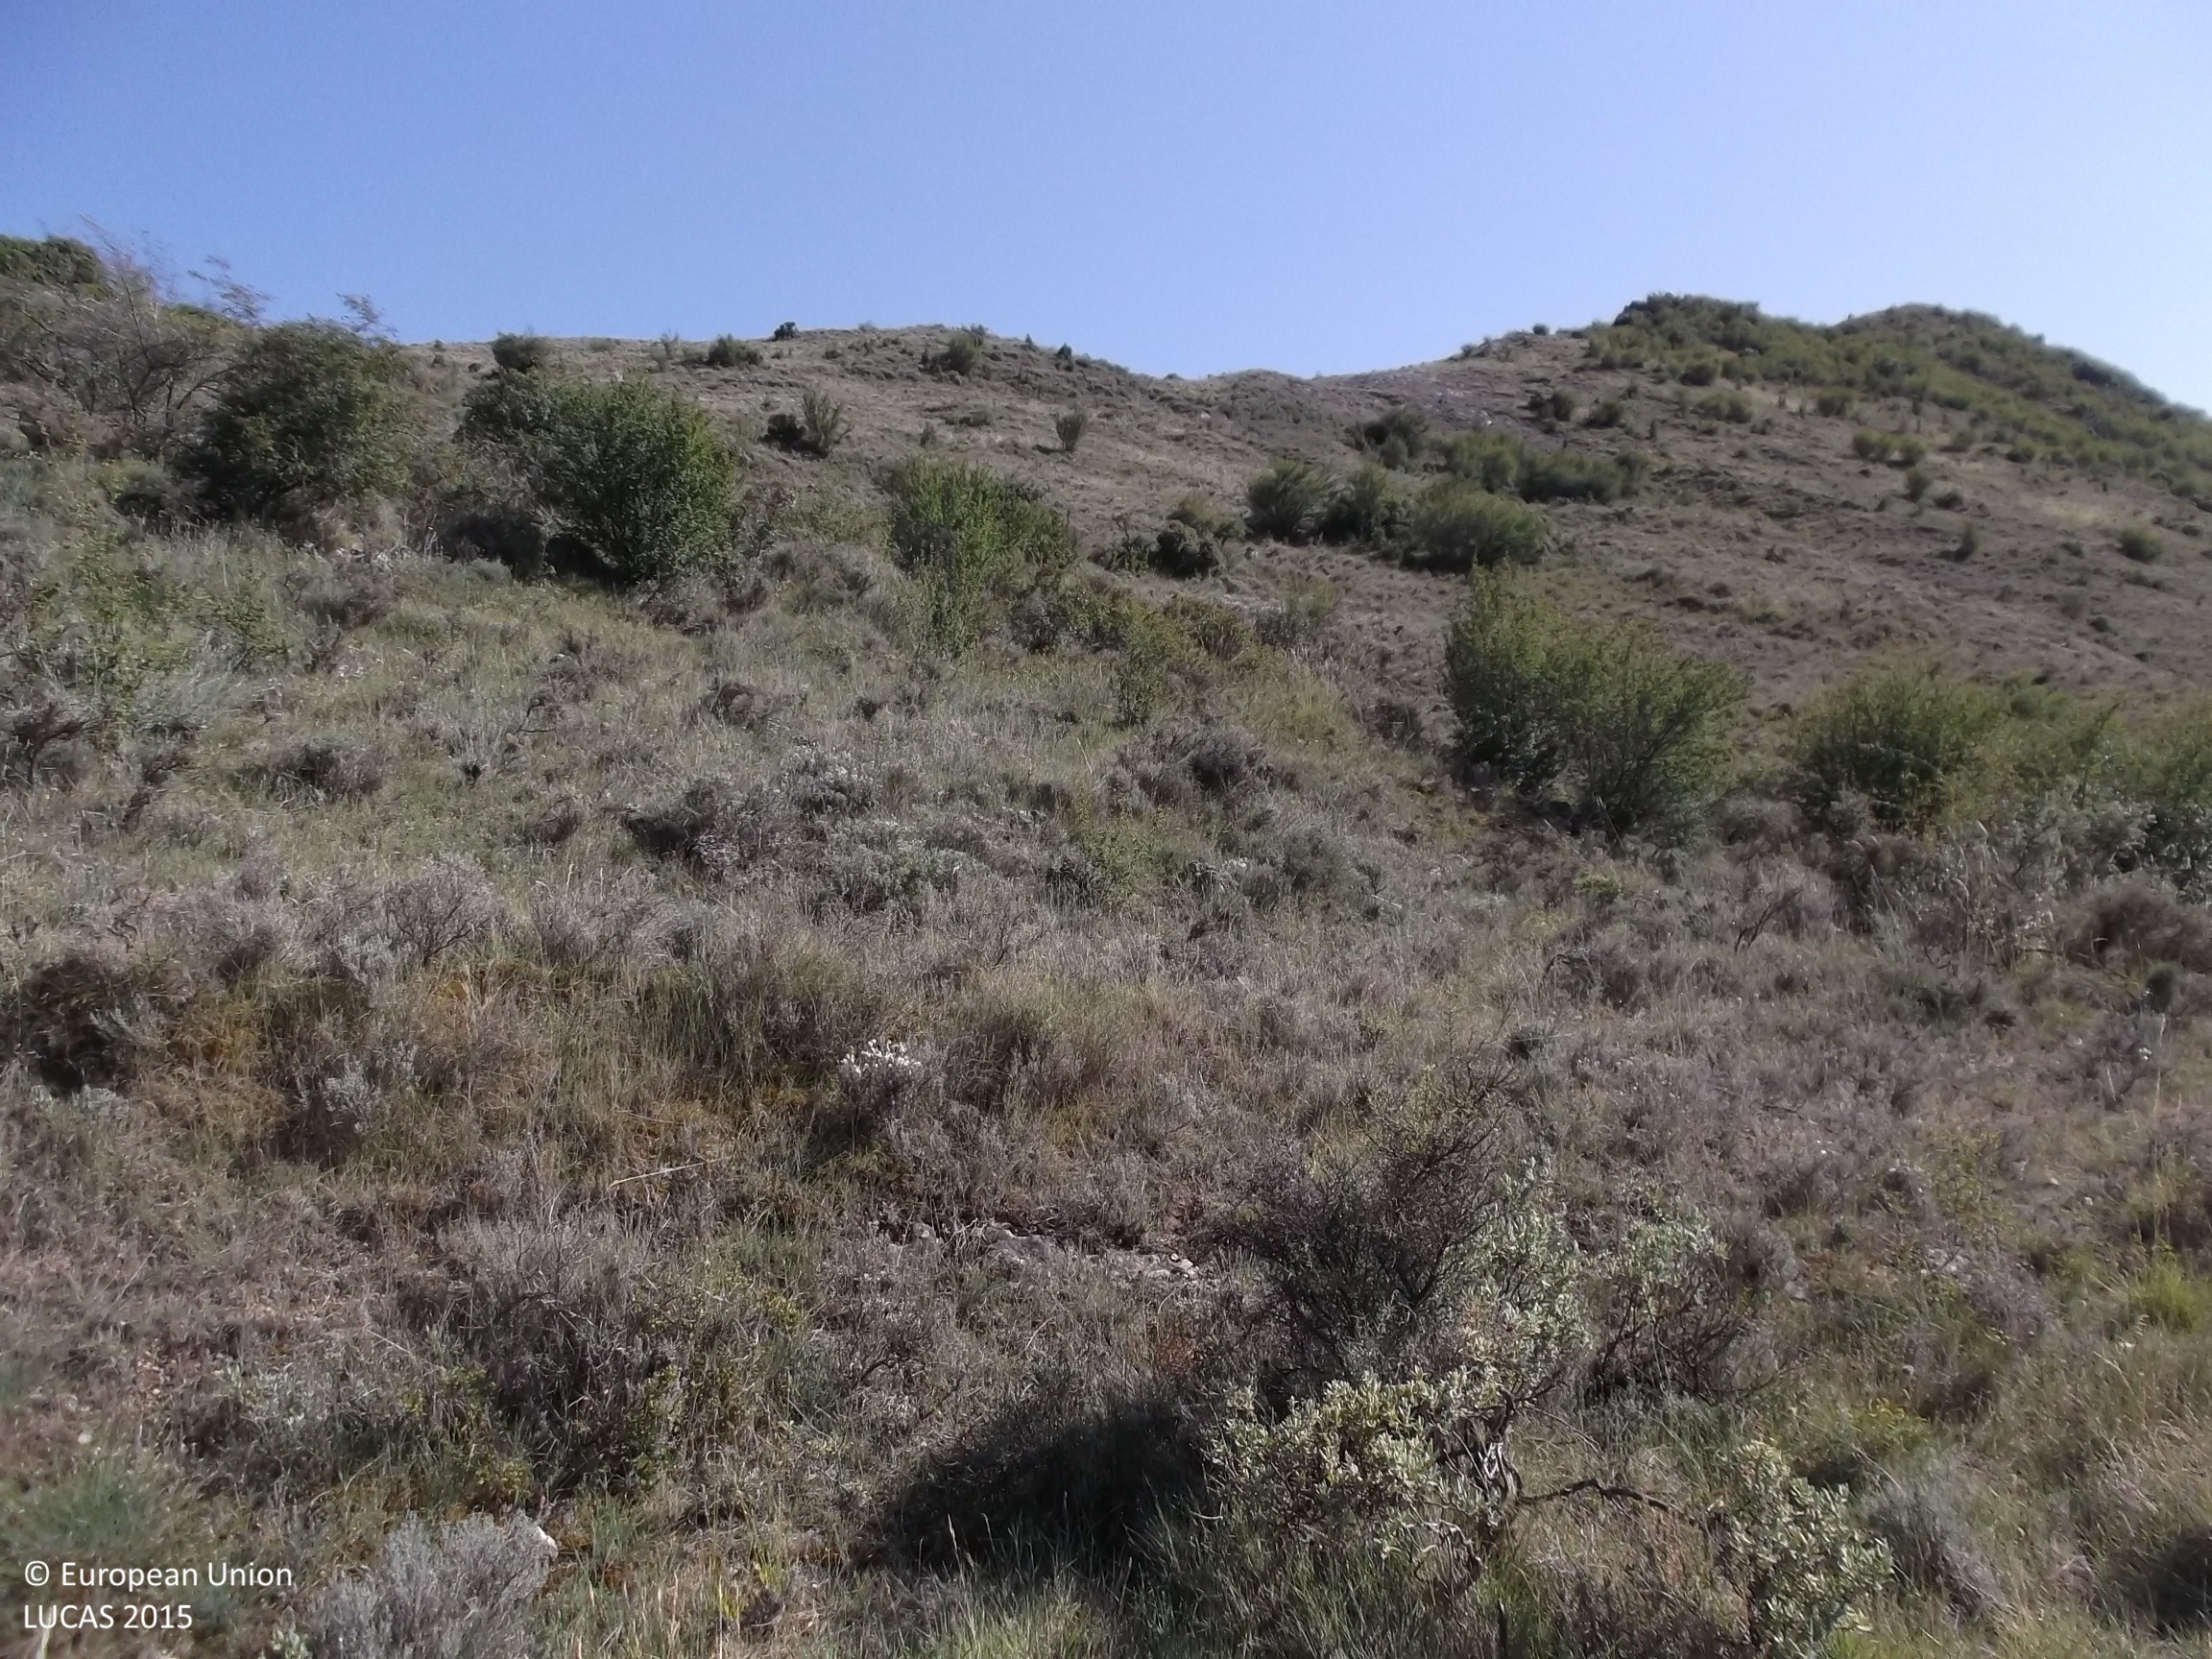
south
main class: Shrubland
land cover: Shrubland with sparse tree cover
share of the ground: 50 - 75 %
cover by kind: shrubs 50 %, herbaceous plants 30 %, unconsolidated bare surface 10 %, broadleaved forest trees 5 %, lichens and mosses 5 %
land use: Semi-natural and natural areas not in use
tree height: < 5 m
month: August
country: ES
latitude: 42.3436
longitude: -2.4121
